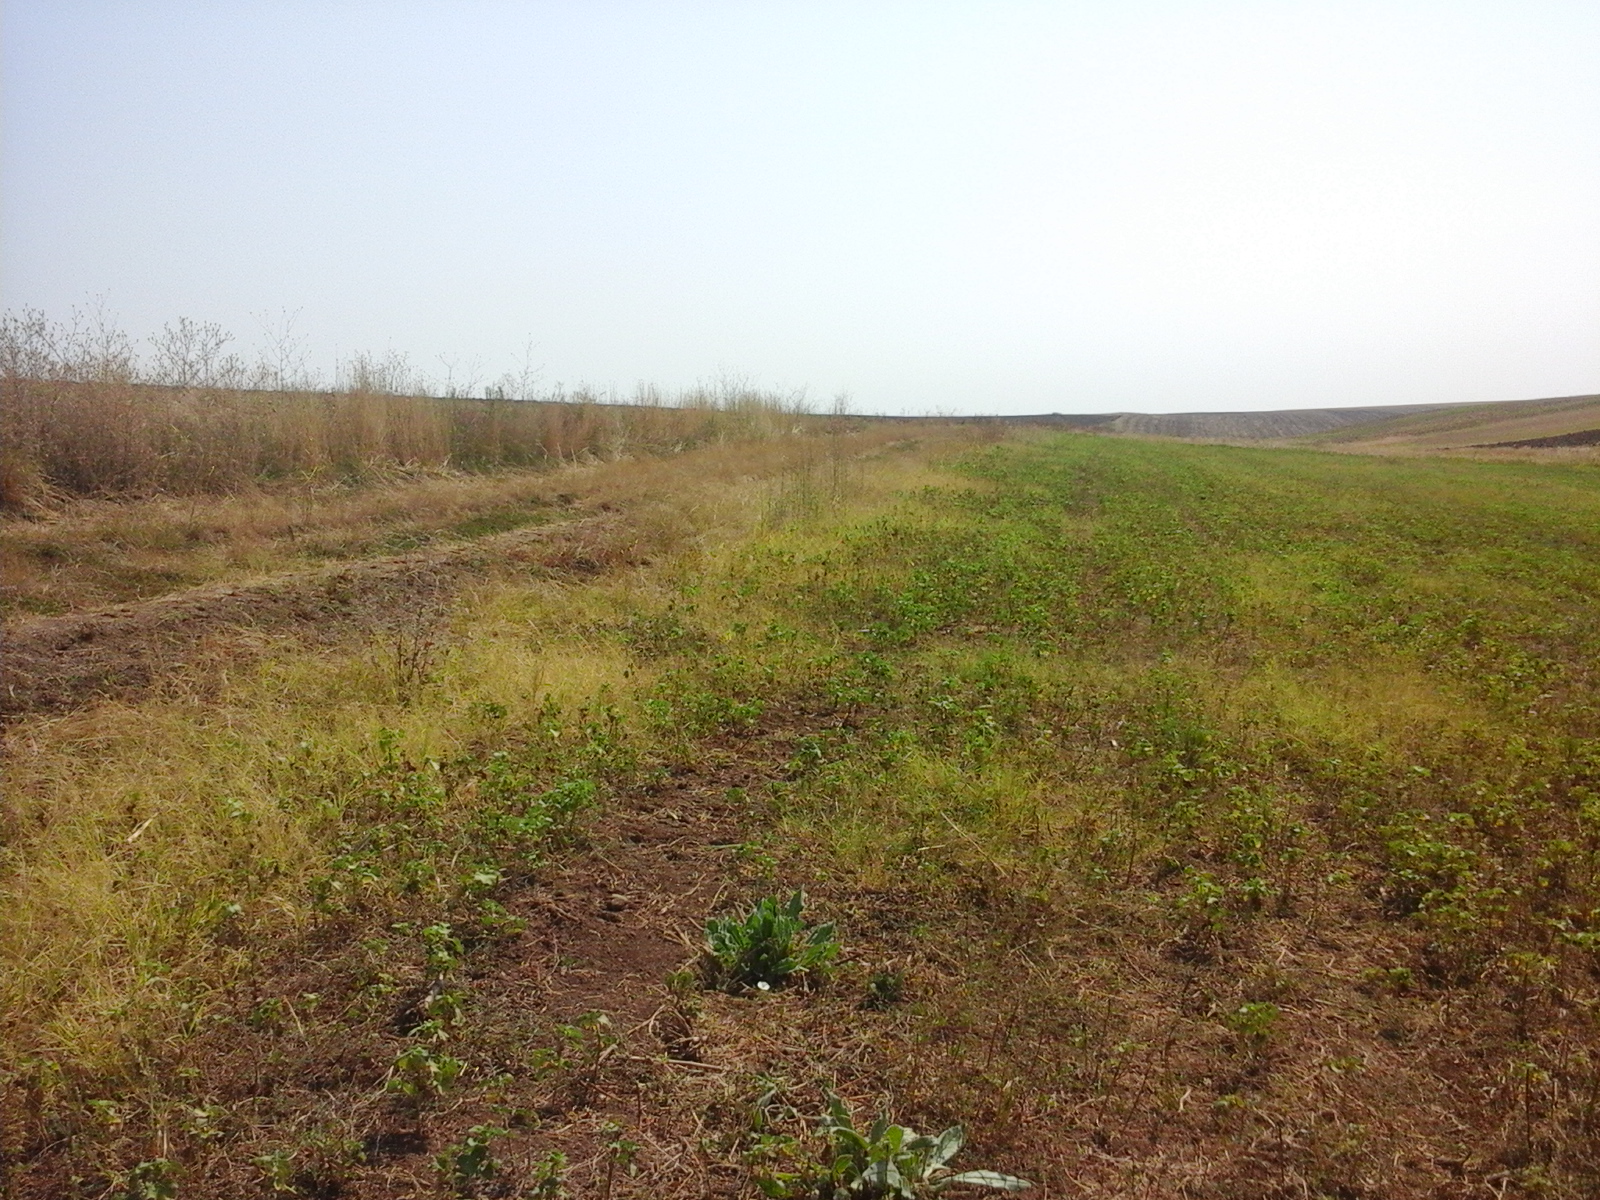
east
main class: Grassland
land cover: Spontaneously vegetated surfaces
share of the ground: > 75 %
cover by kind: herbaceous plants 100 %
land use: Fallow land
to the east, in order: Spontaneously vegetated surfaces; Grass margins; Tracks; Grass margins; Common wheat
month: August
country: RO
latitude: 44.2023
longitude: 23.2994
